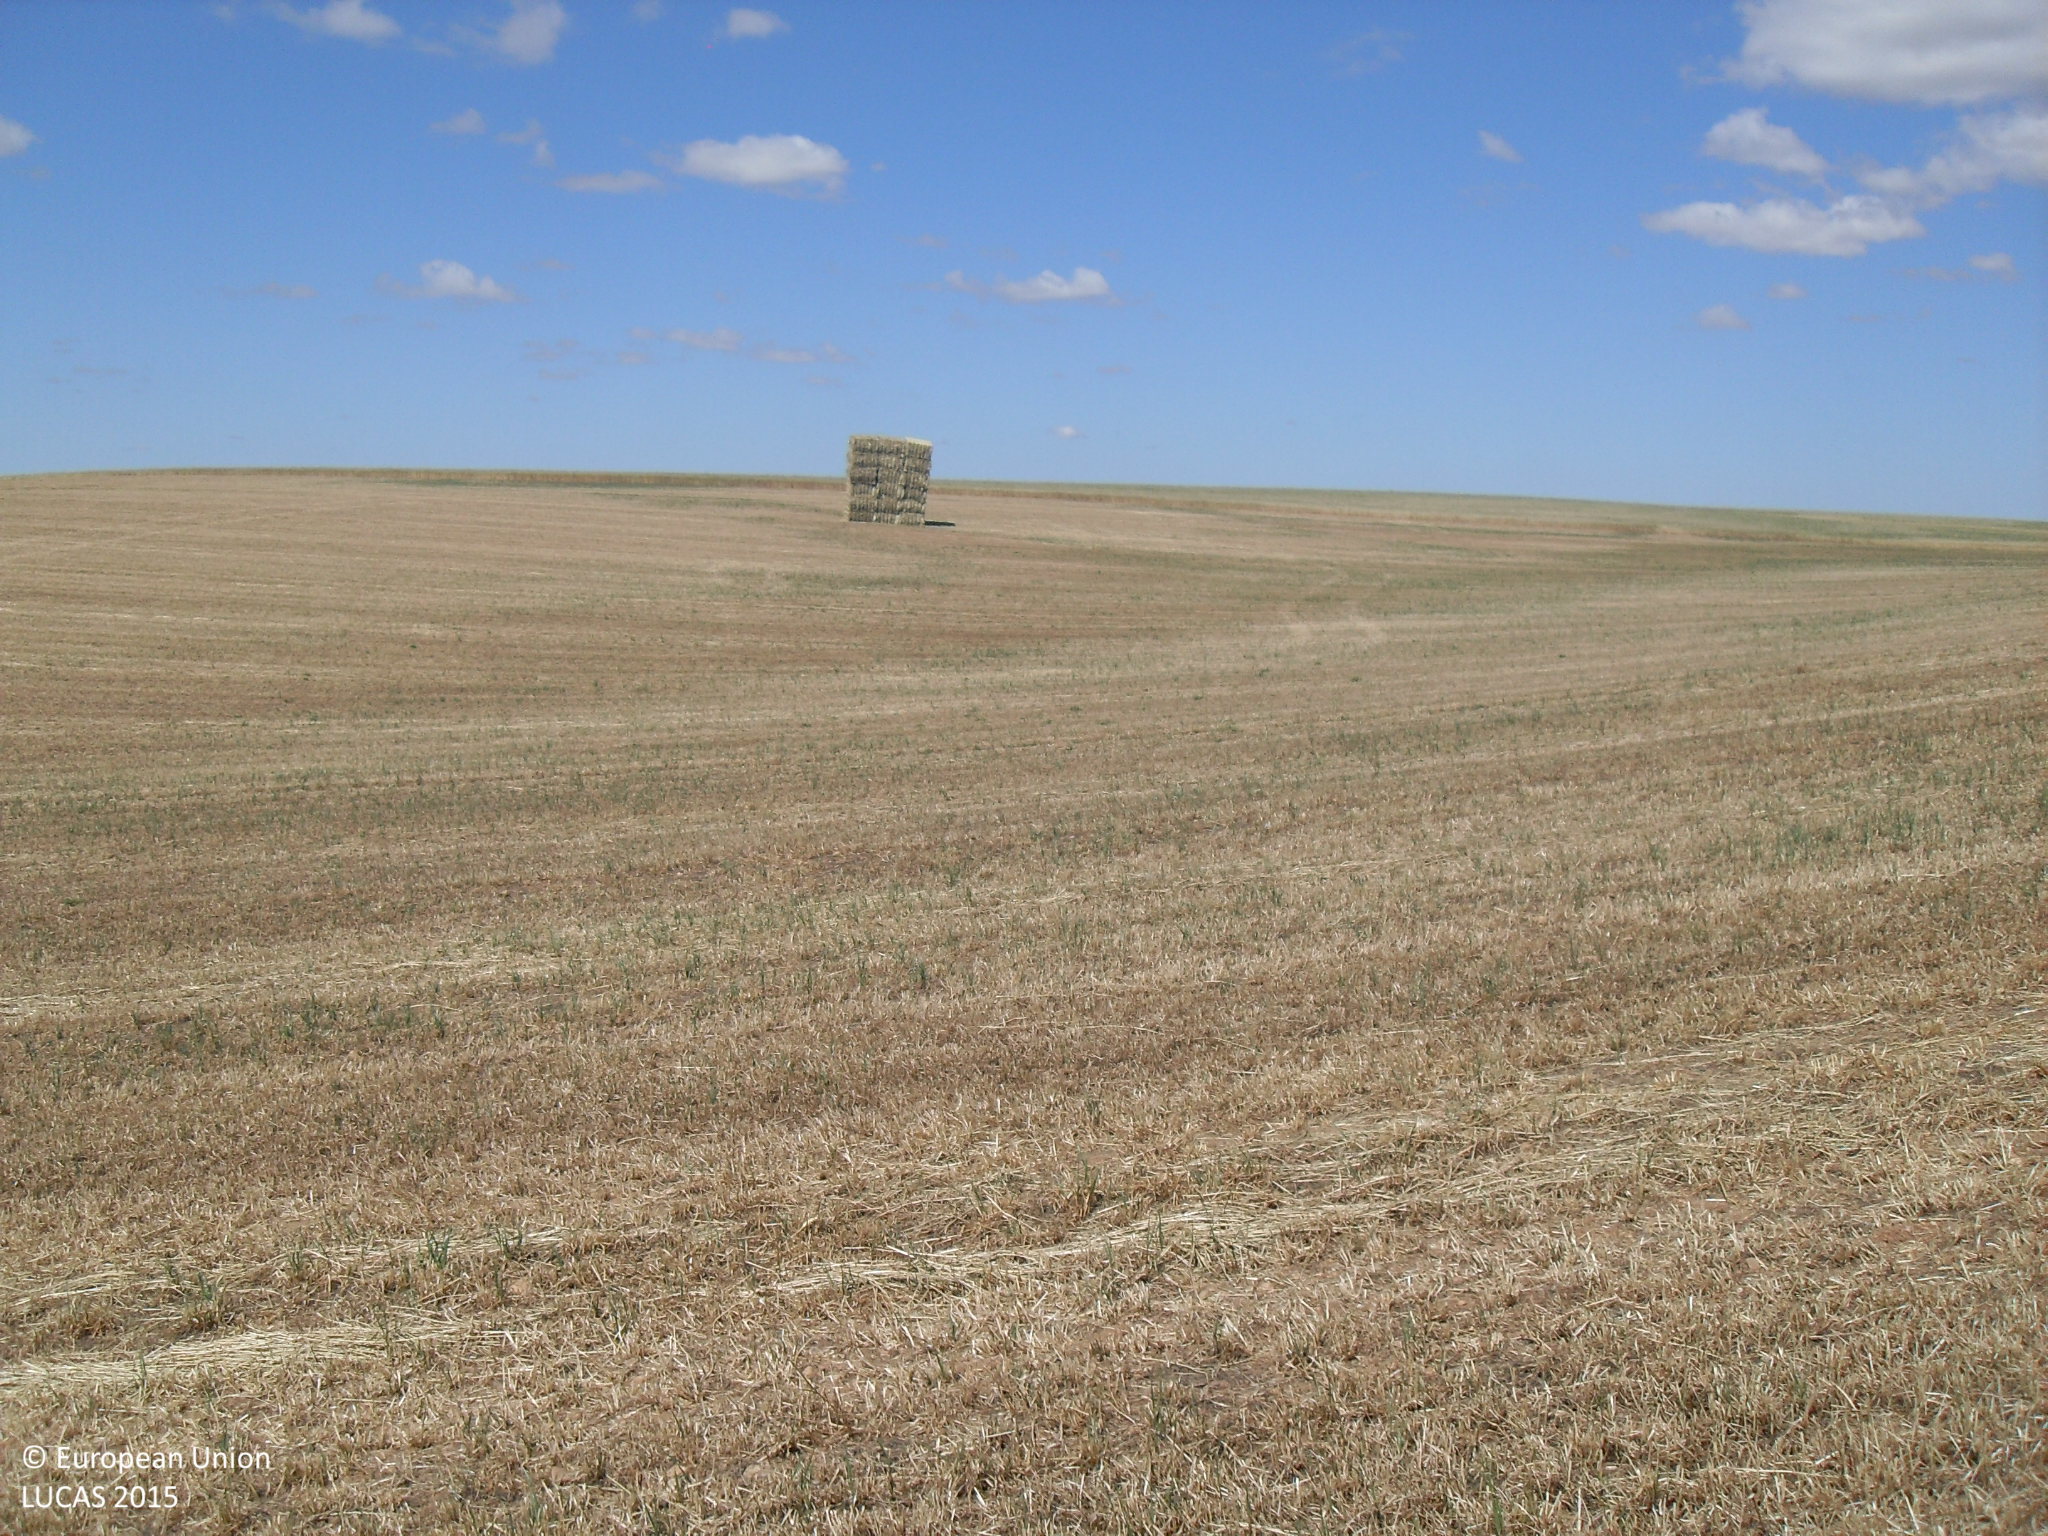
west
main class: Cropland
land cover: Oats
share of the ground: > 75 %
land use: Agriculture (excluding fallow land and kitchen gardens)
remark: Harvested field
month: May
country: ES
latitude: 41.1372
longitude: -5.2856
